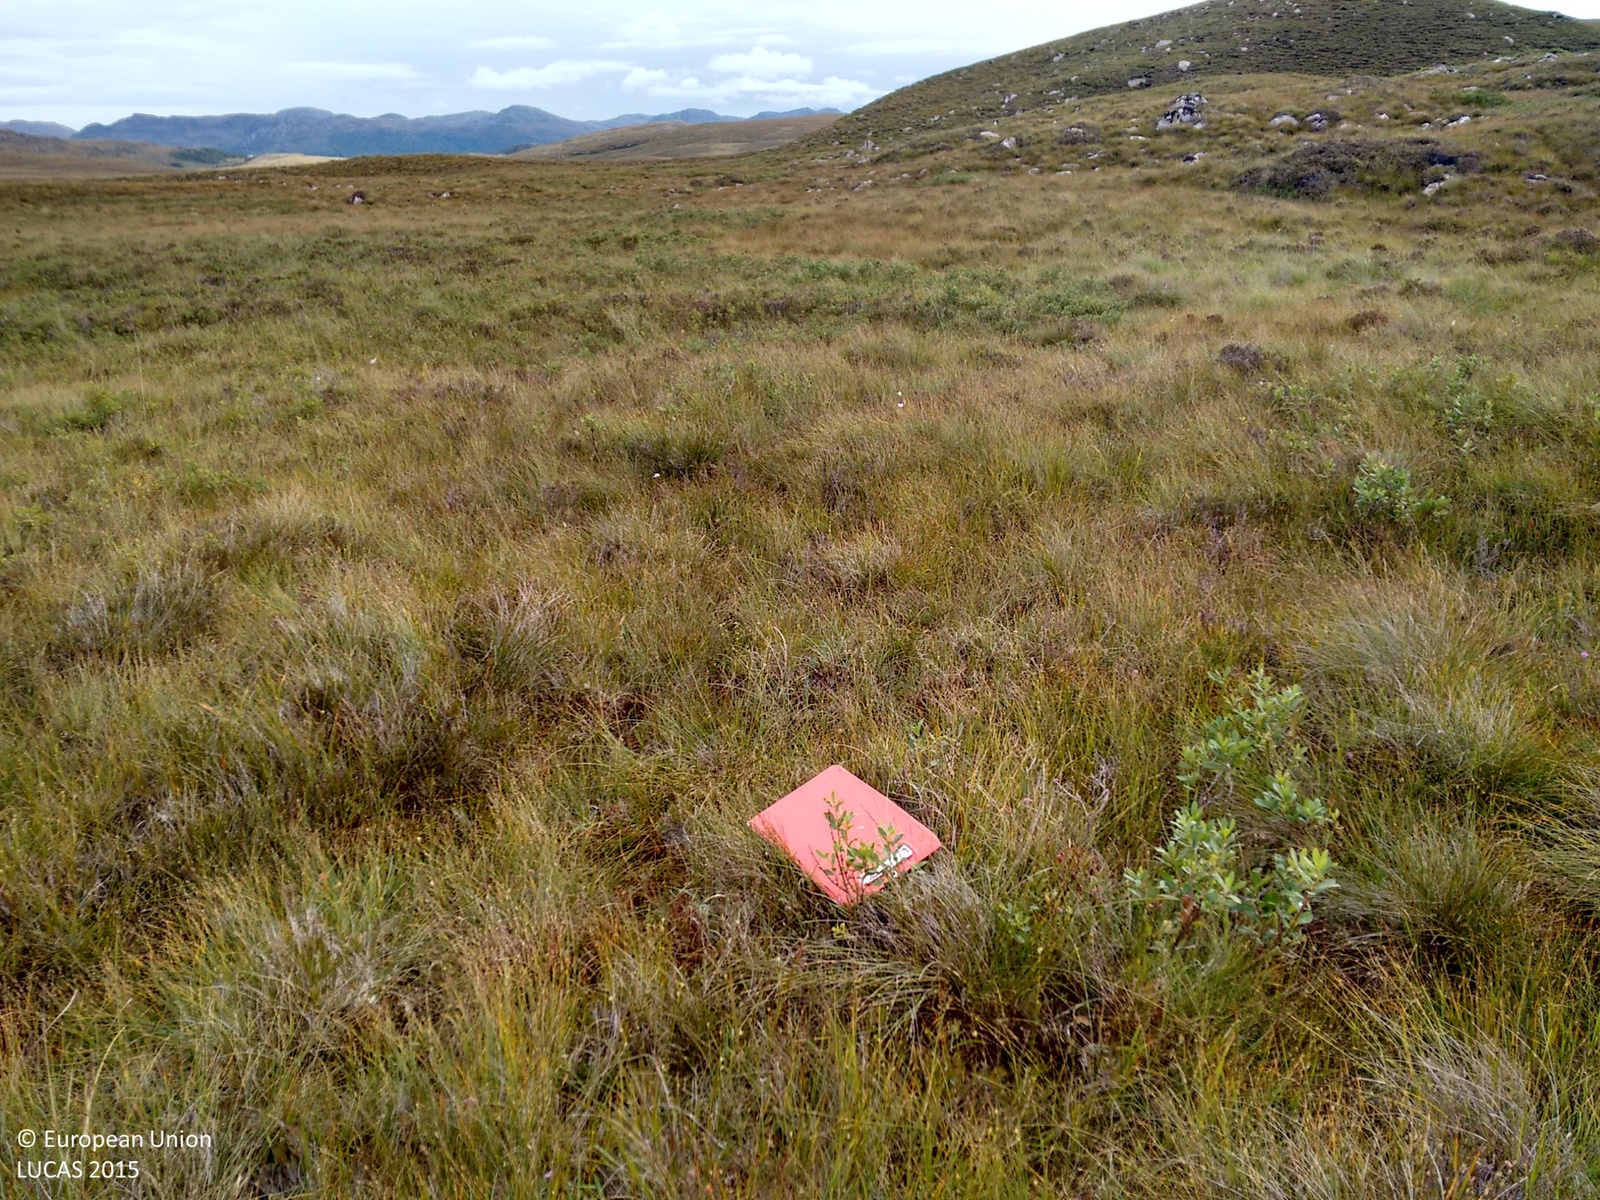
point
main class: Shrubland
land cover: Shrubland without tree cover
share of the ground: > 75 %
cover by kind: herbaceous plants 60 %, shrubs 40 %
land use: Agriculture (excluding fallow land and kitchen gardens)
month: September
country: GB
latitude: 57.6841
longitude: -5.7691
